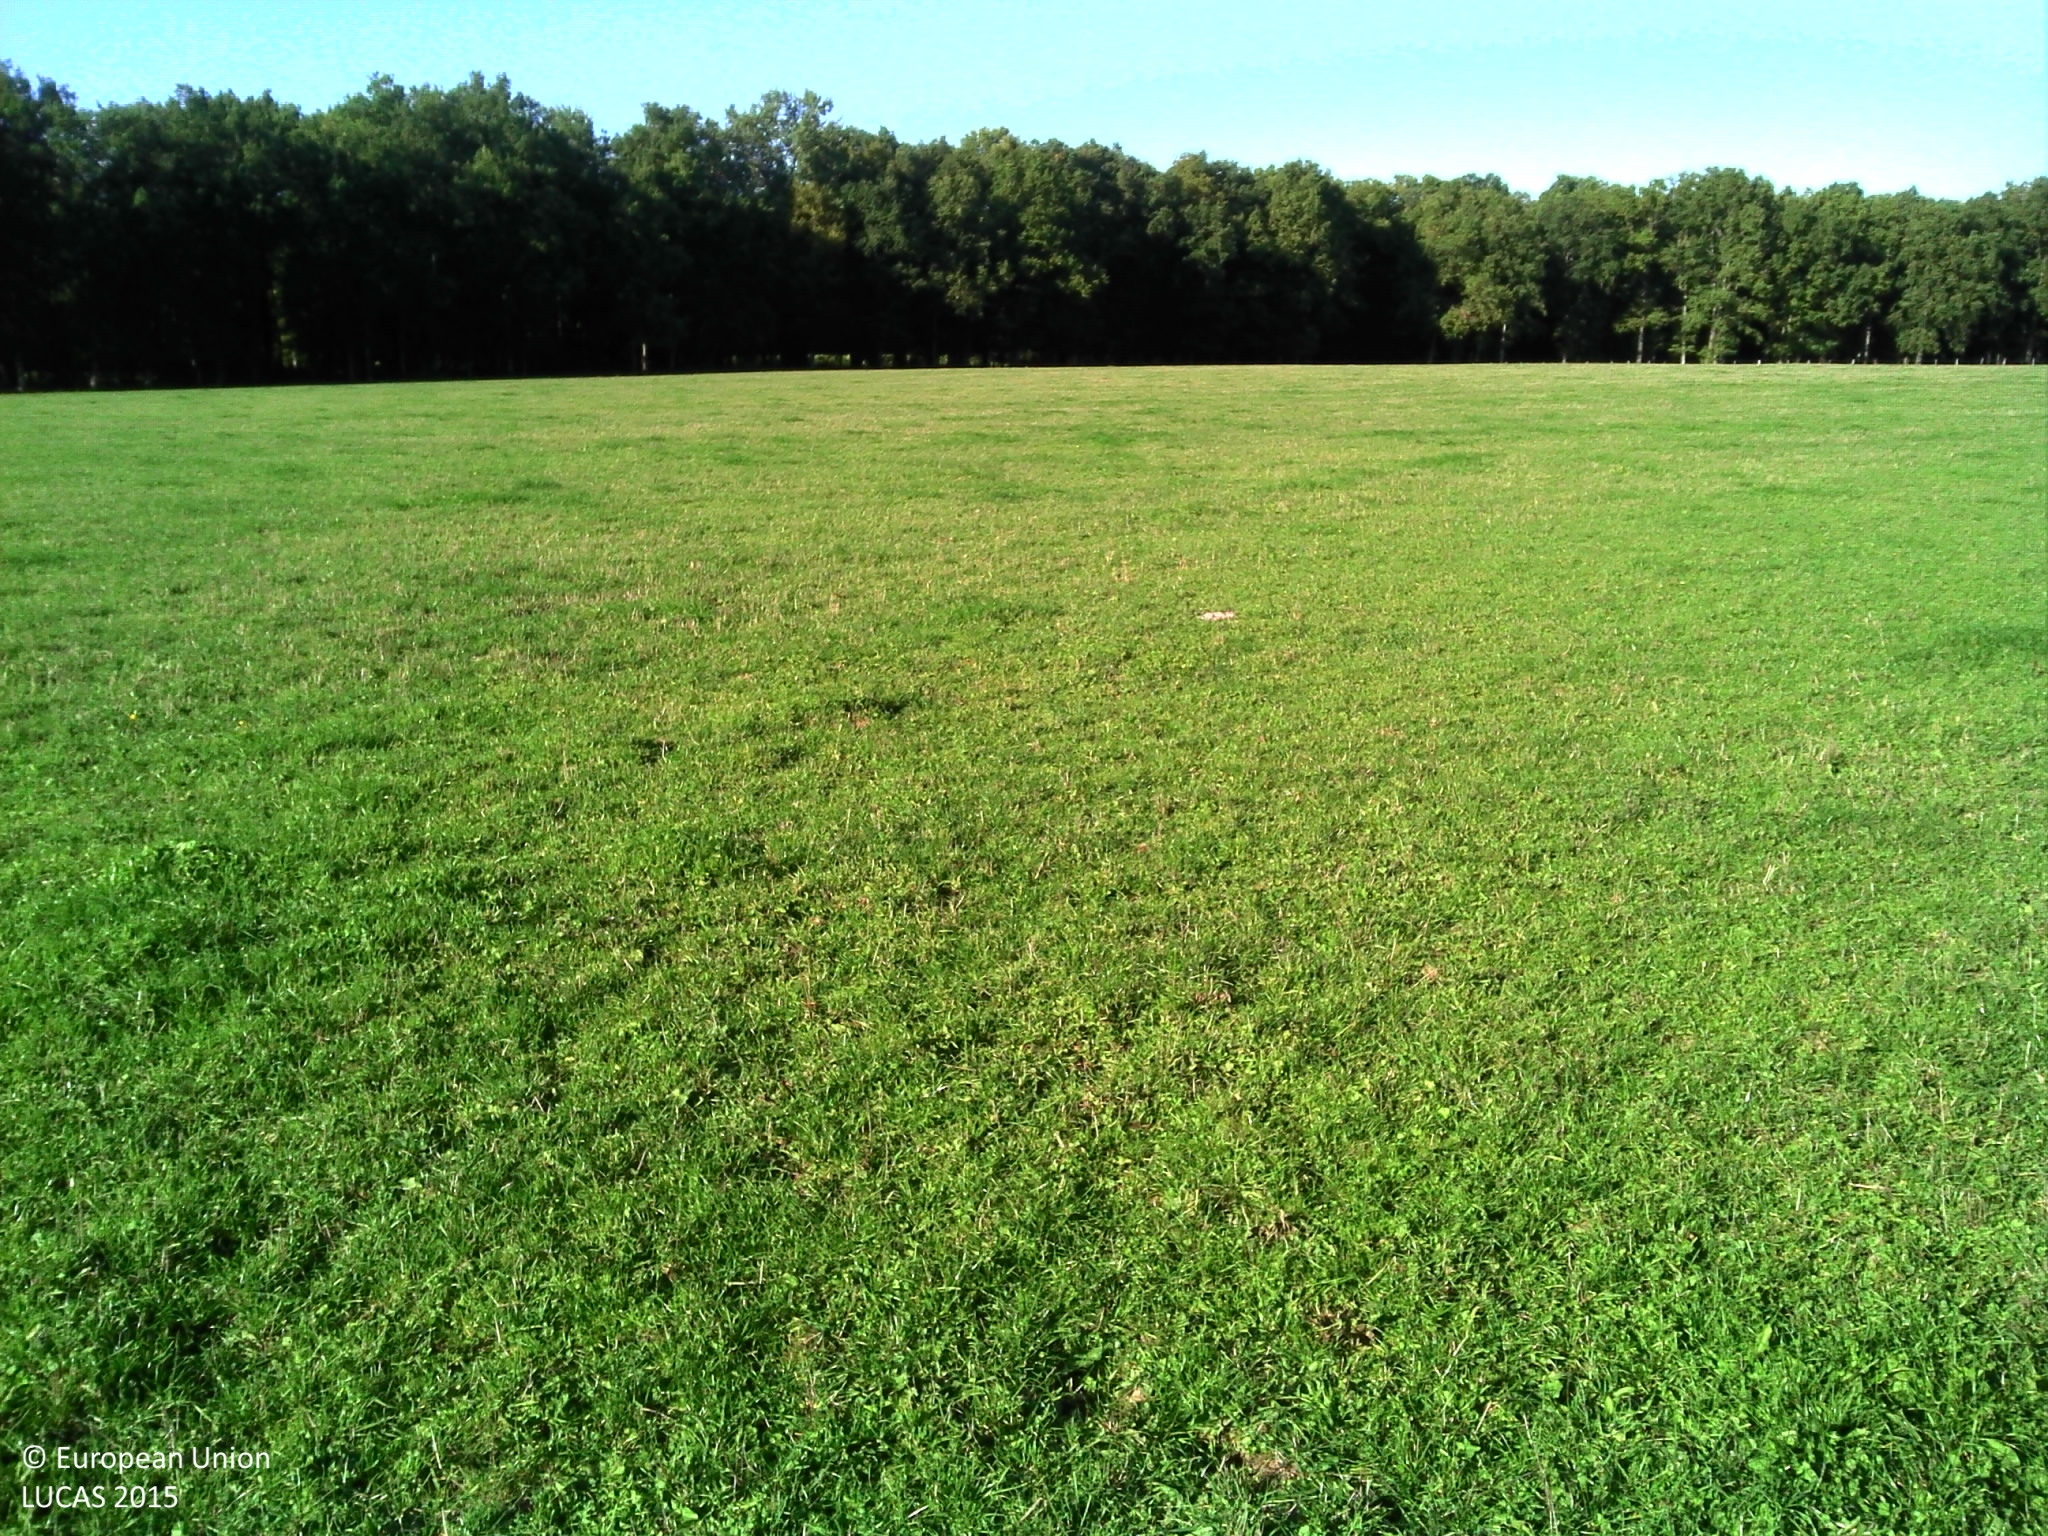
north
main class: Grassland
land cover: Grassland without tree/shrub cover
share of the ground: > 75 %
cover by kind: herbaceous plants 100 %
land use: Agriculture (excluding fallow land and kitchen gardens)
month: September
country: FR
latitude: 48.3296
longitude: 4.3183
